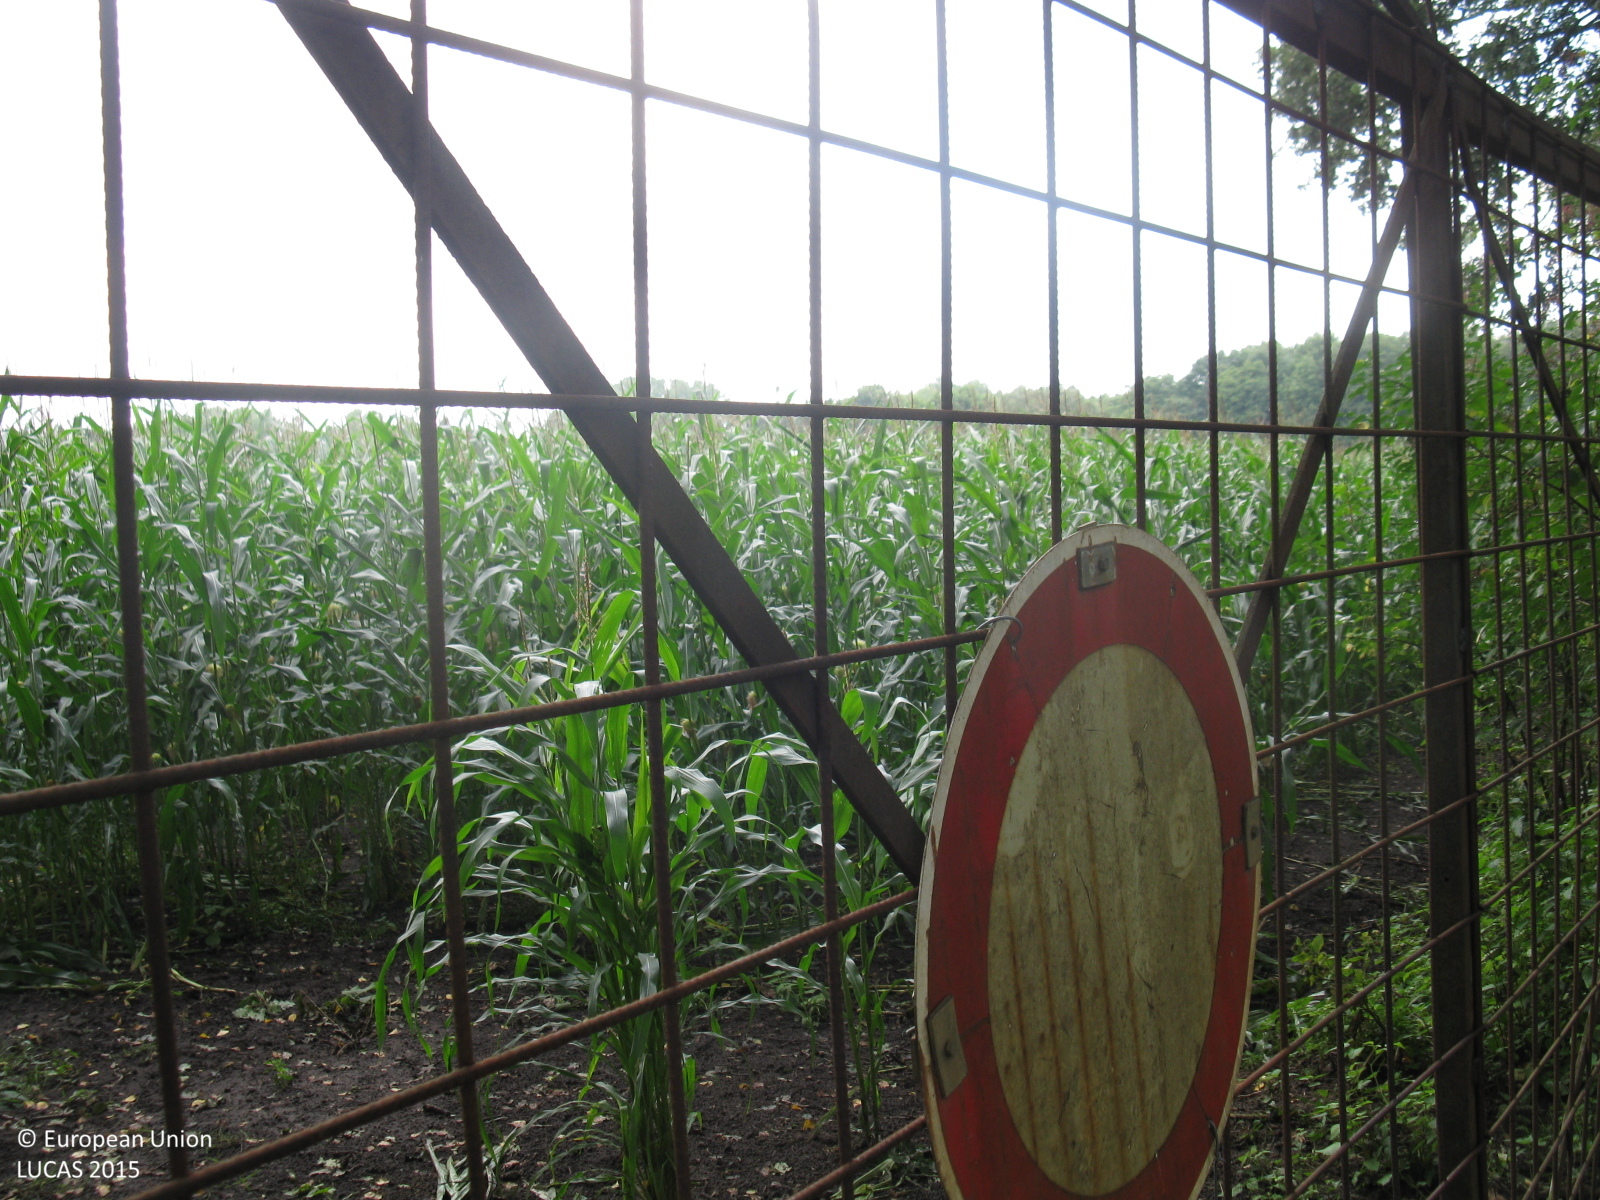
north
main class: Cropland
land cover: Maize
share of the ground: > 75 %
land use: Agriculture (excluding fallow land and kitchen gardens)
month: August
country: DE
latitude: 51.7266
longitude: 6.9452
